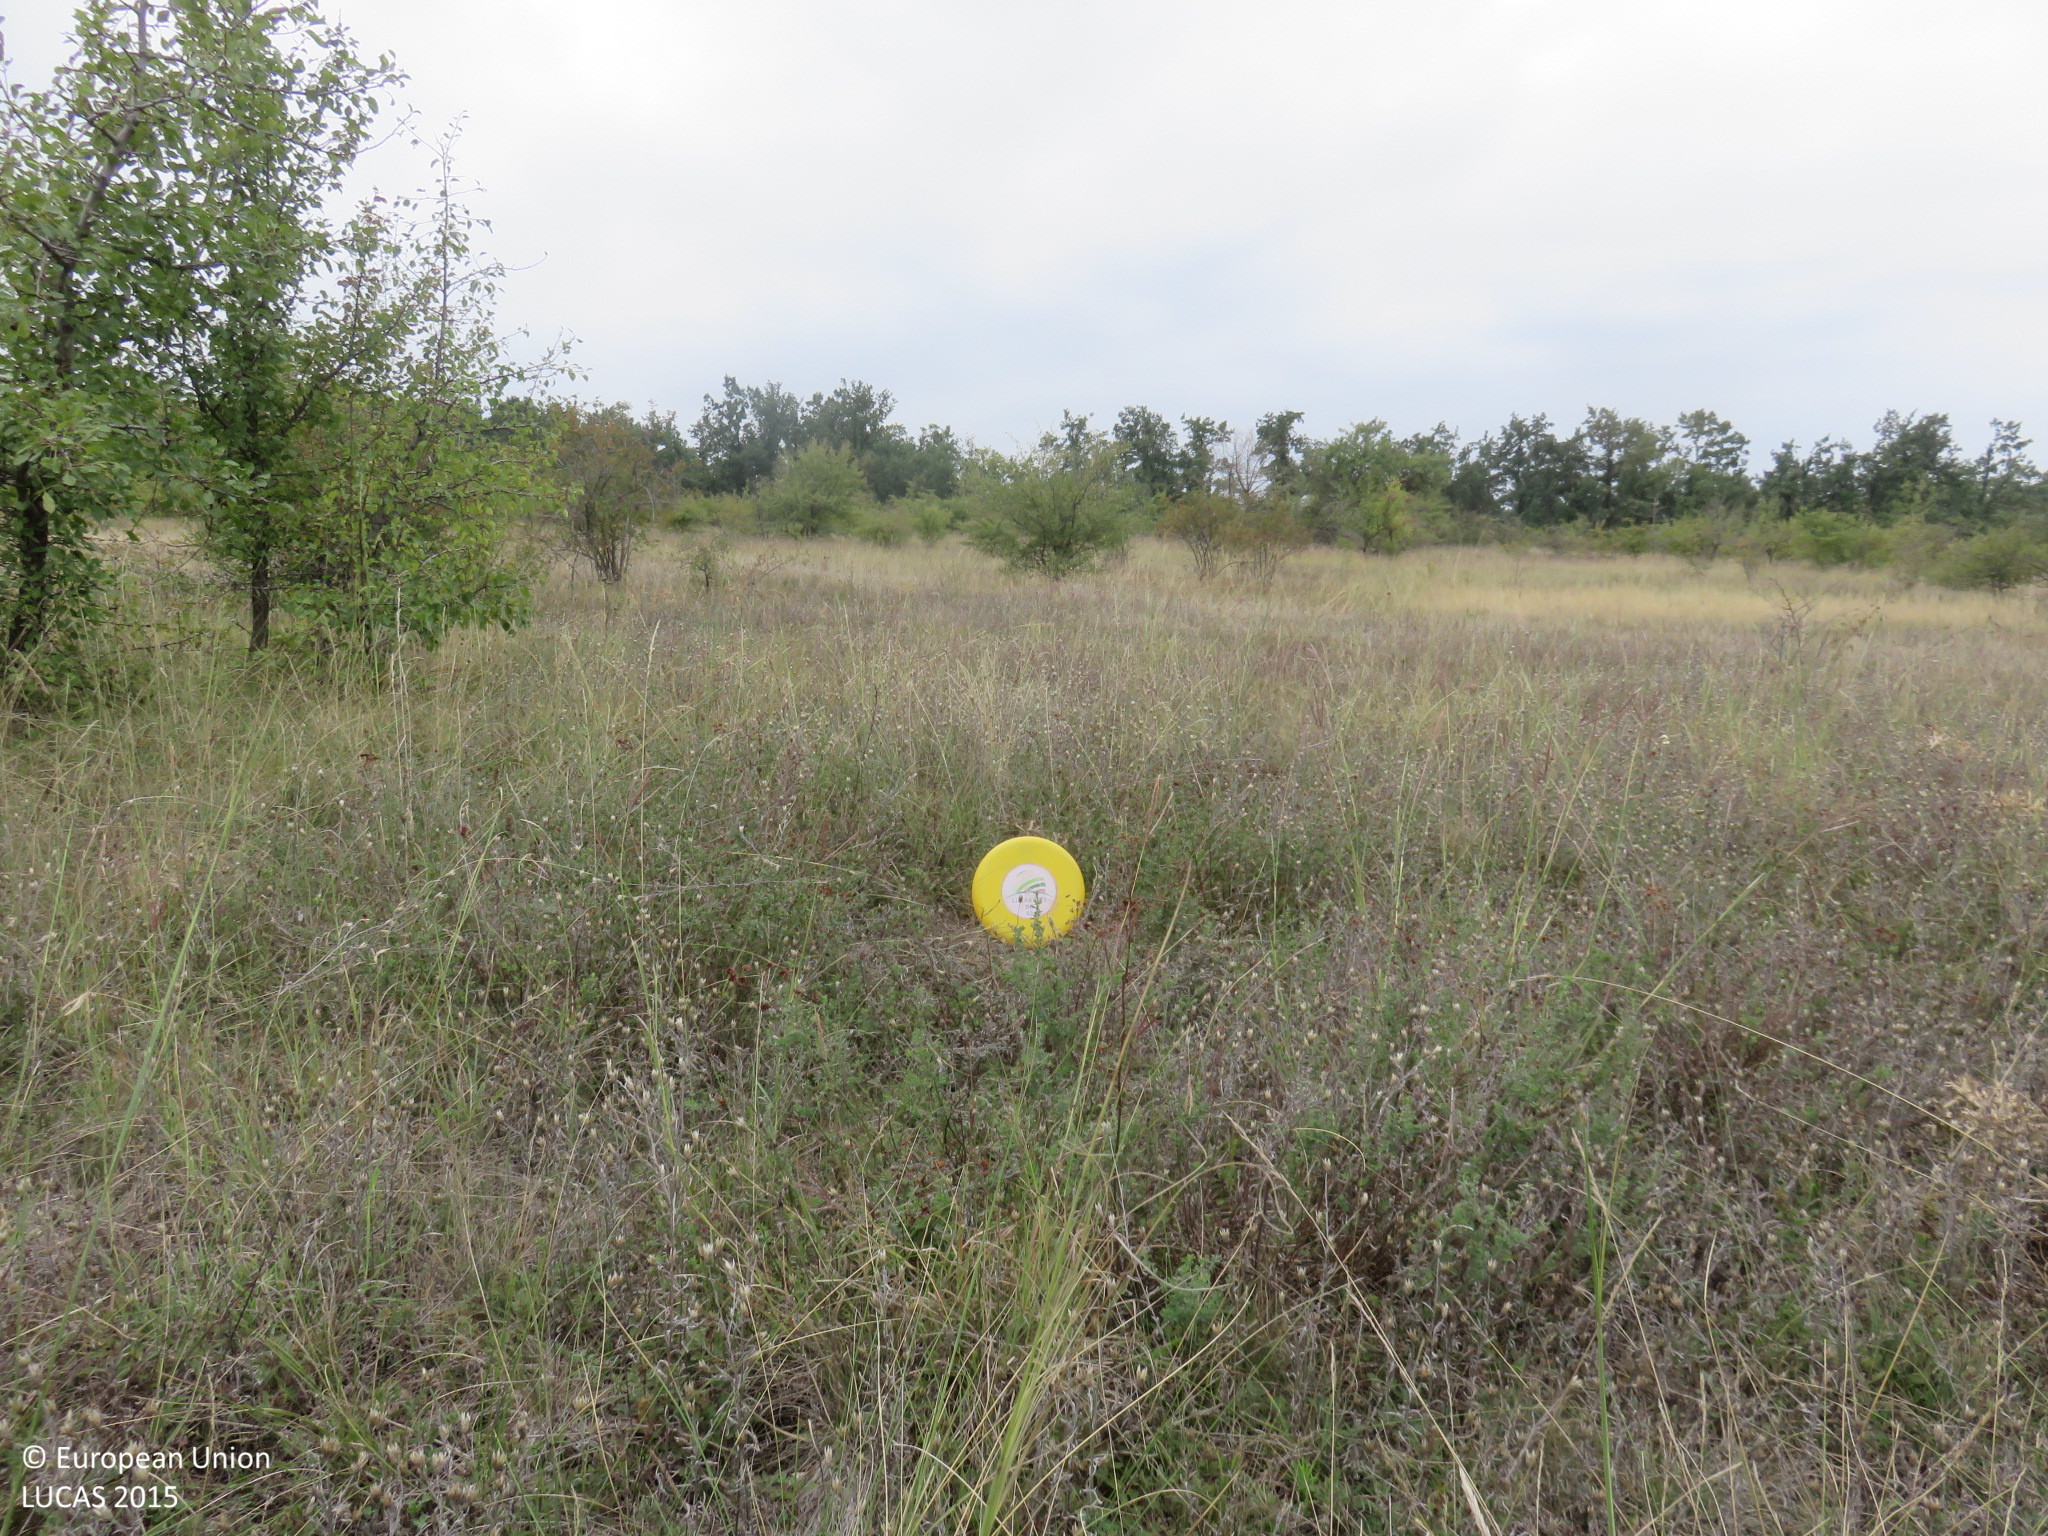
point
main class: Grassland
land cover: Grassland with sparse tree/shrub cover
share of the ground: > 75 %
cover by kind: herbaceous plants 90 %, broadleaved forest trees 5 %, shrubs 5 %
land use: Agriculture (excluding fallow land and kitchen gardens)
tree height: < 5 m
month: September
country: BG
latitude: 43.1917
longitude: 24.9185
